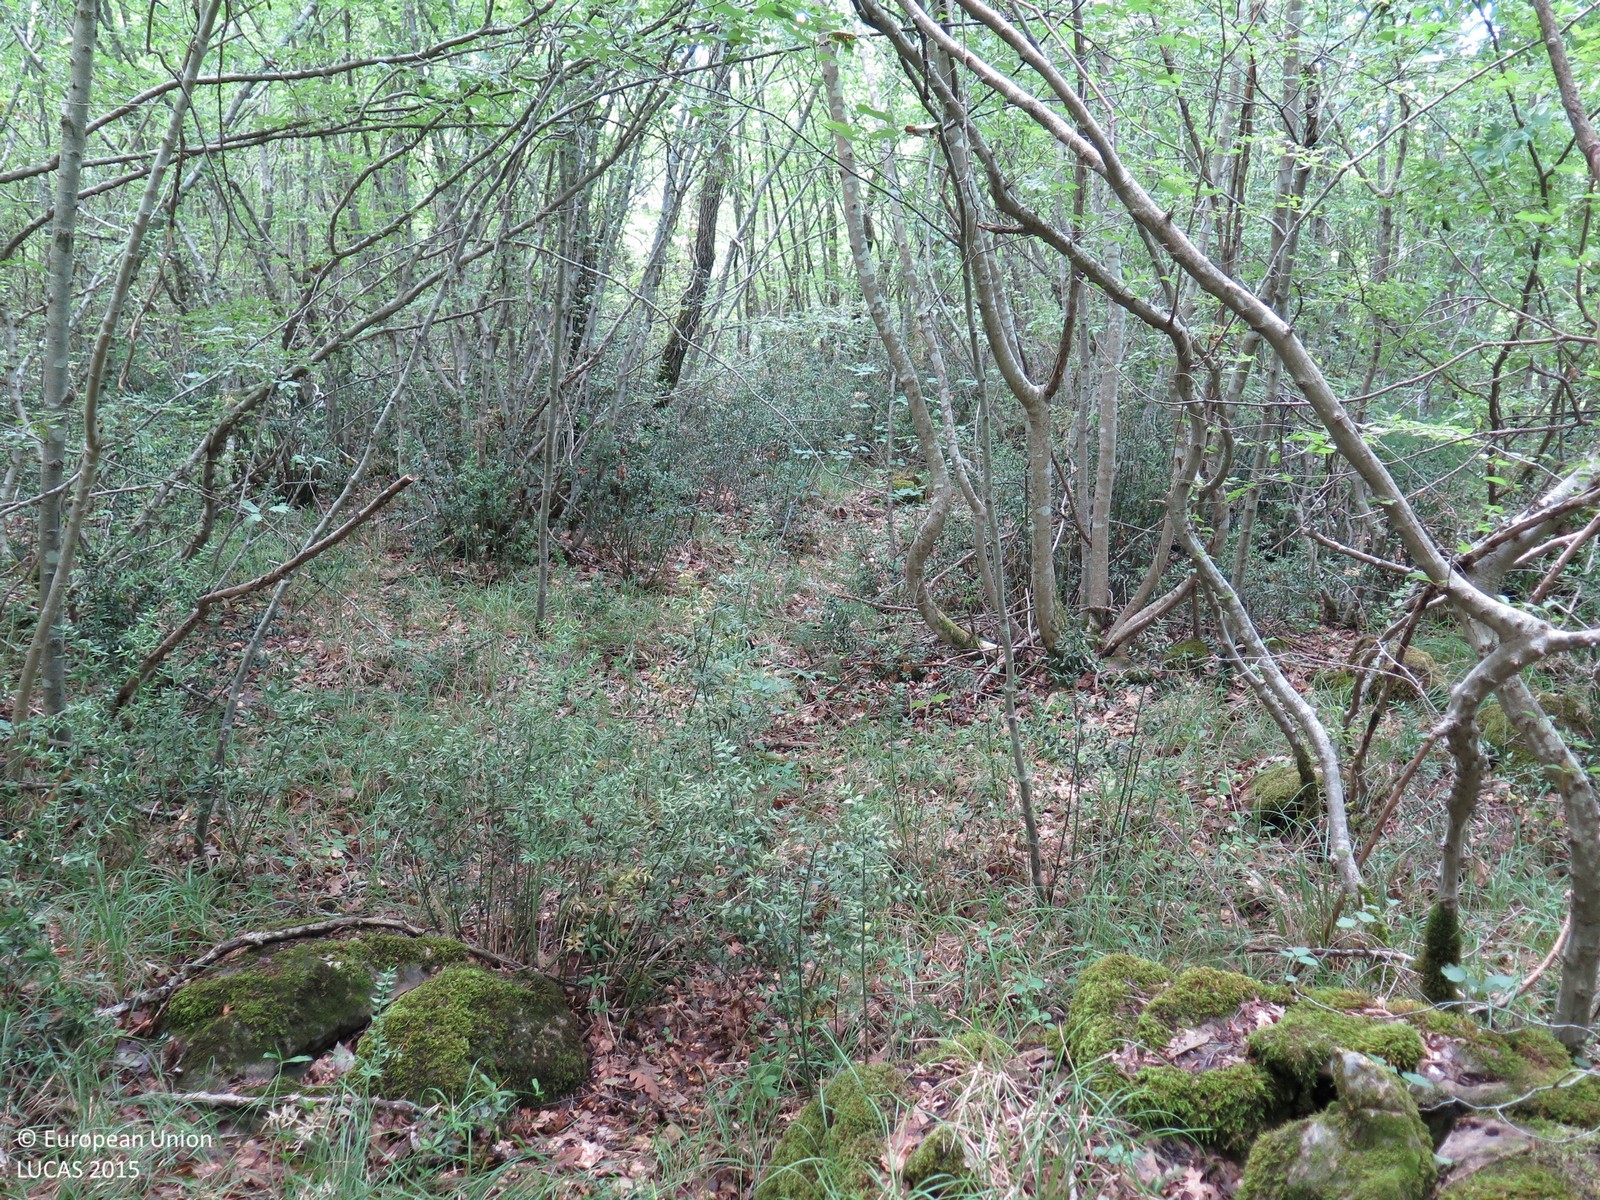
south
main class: Woodland
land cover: Broadleaved woodland
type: beech forest
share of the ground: > 75 %
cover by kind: broadleaved forest trees 90 %, shrubs 5 %, herbaceous plants 5 %
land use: Semi-natural and natural areas not in use
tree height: > 5 m
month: June
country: HR
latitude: 45.2437
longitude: 13.6258
